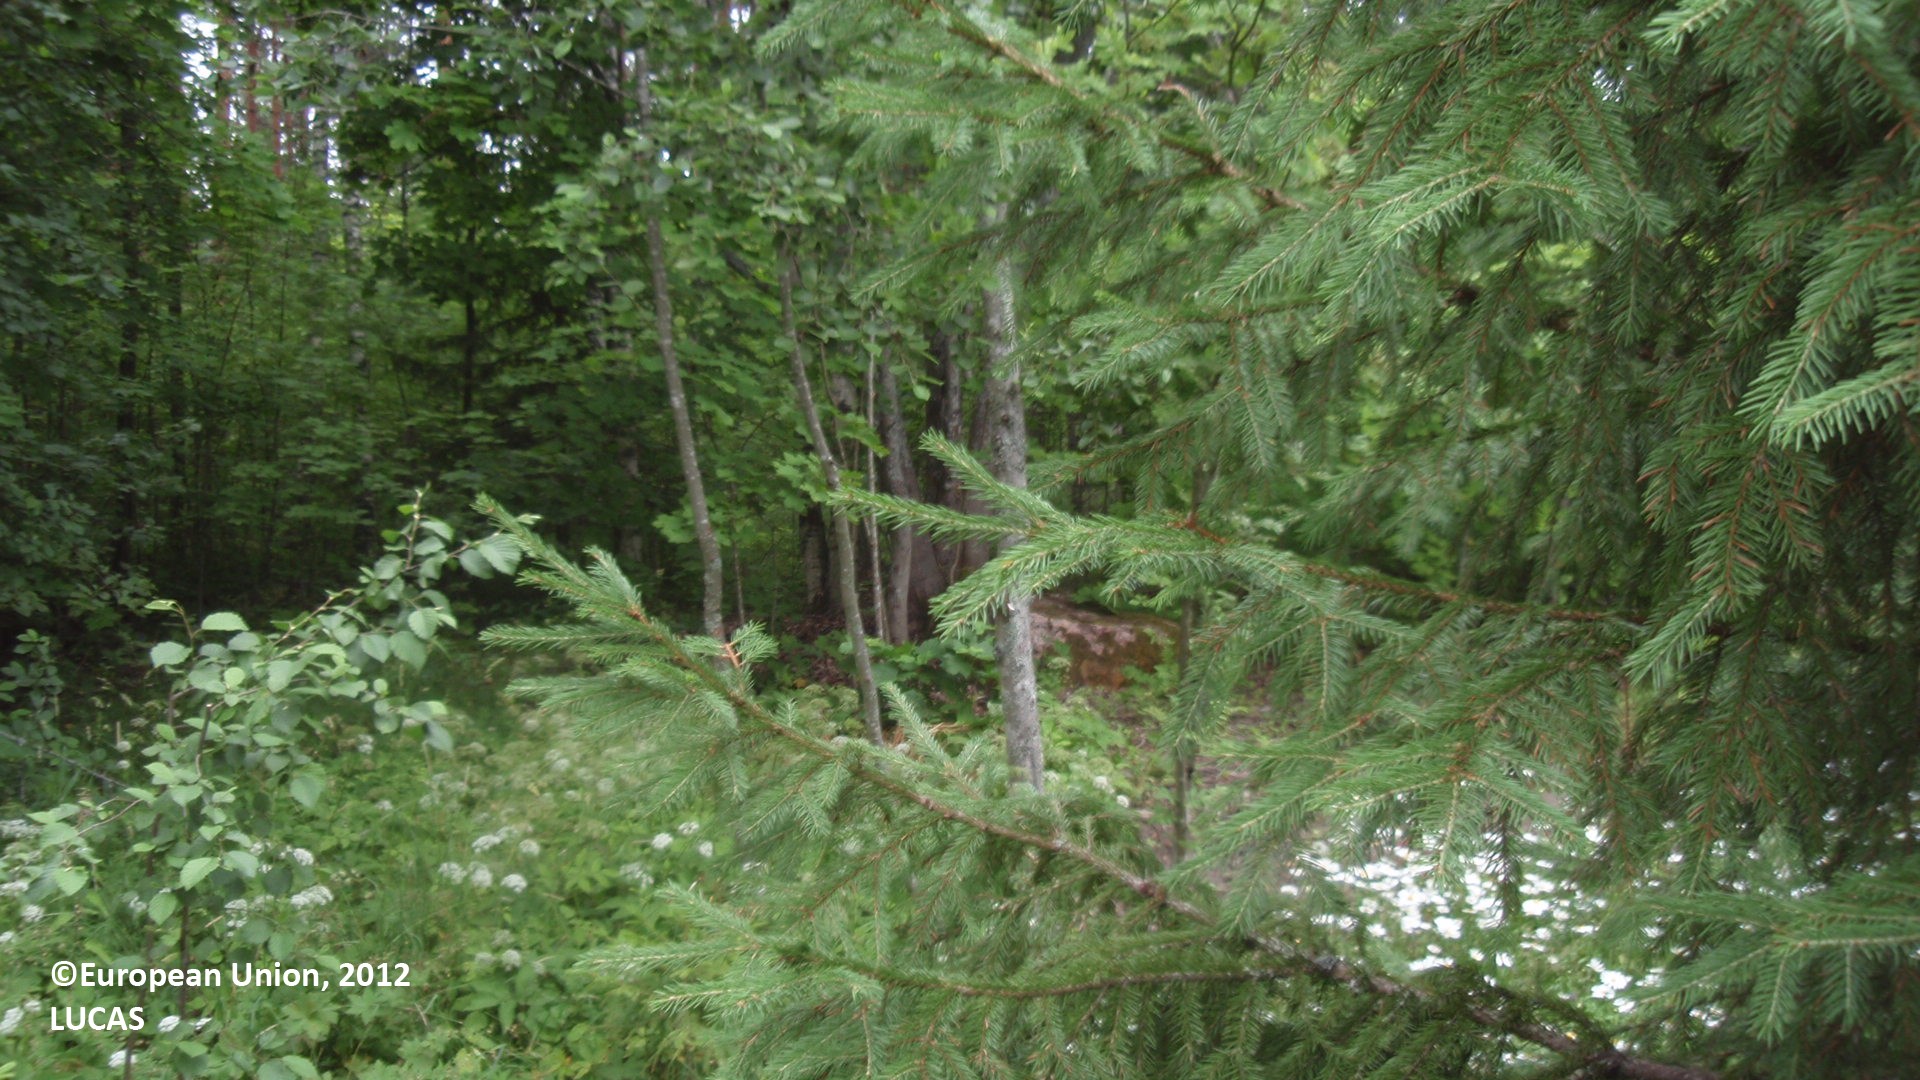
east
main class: Grassland
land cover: Grassland with sparse tree/shrub cover
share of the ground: > 75 %
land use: Residential
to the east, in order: Grassland with sparse tree/shrub cover; Broadleaved woodland; Pine dominated mixed woodland; Spruce dominated mixed woodland; Grassland without tree/shrub cover; Paved roads, cycling and walking lanes; Grassland without tree/shrub cover; Paved roads, cycling and walking lanes; Grassland with sparse tree/shrub cover; Spruce dominated mixed woodland
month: July
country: FI
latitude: 61.1850
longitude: 28.8069
